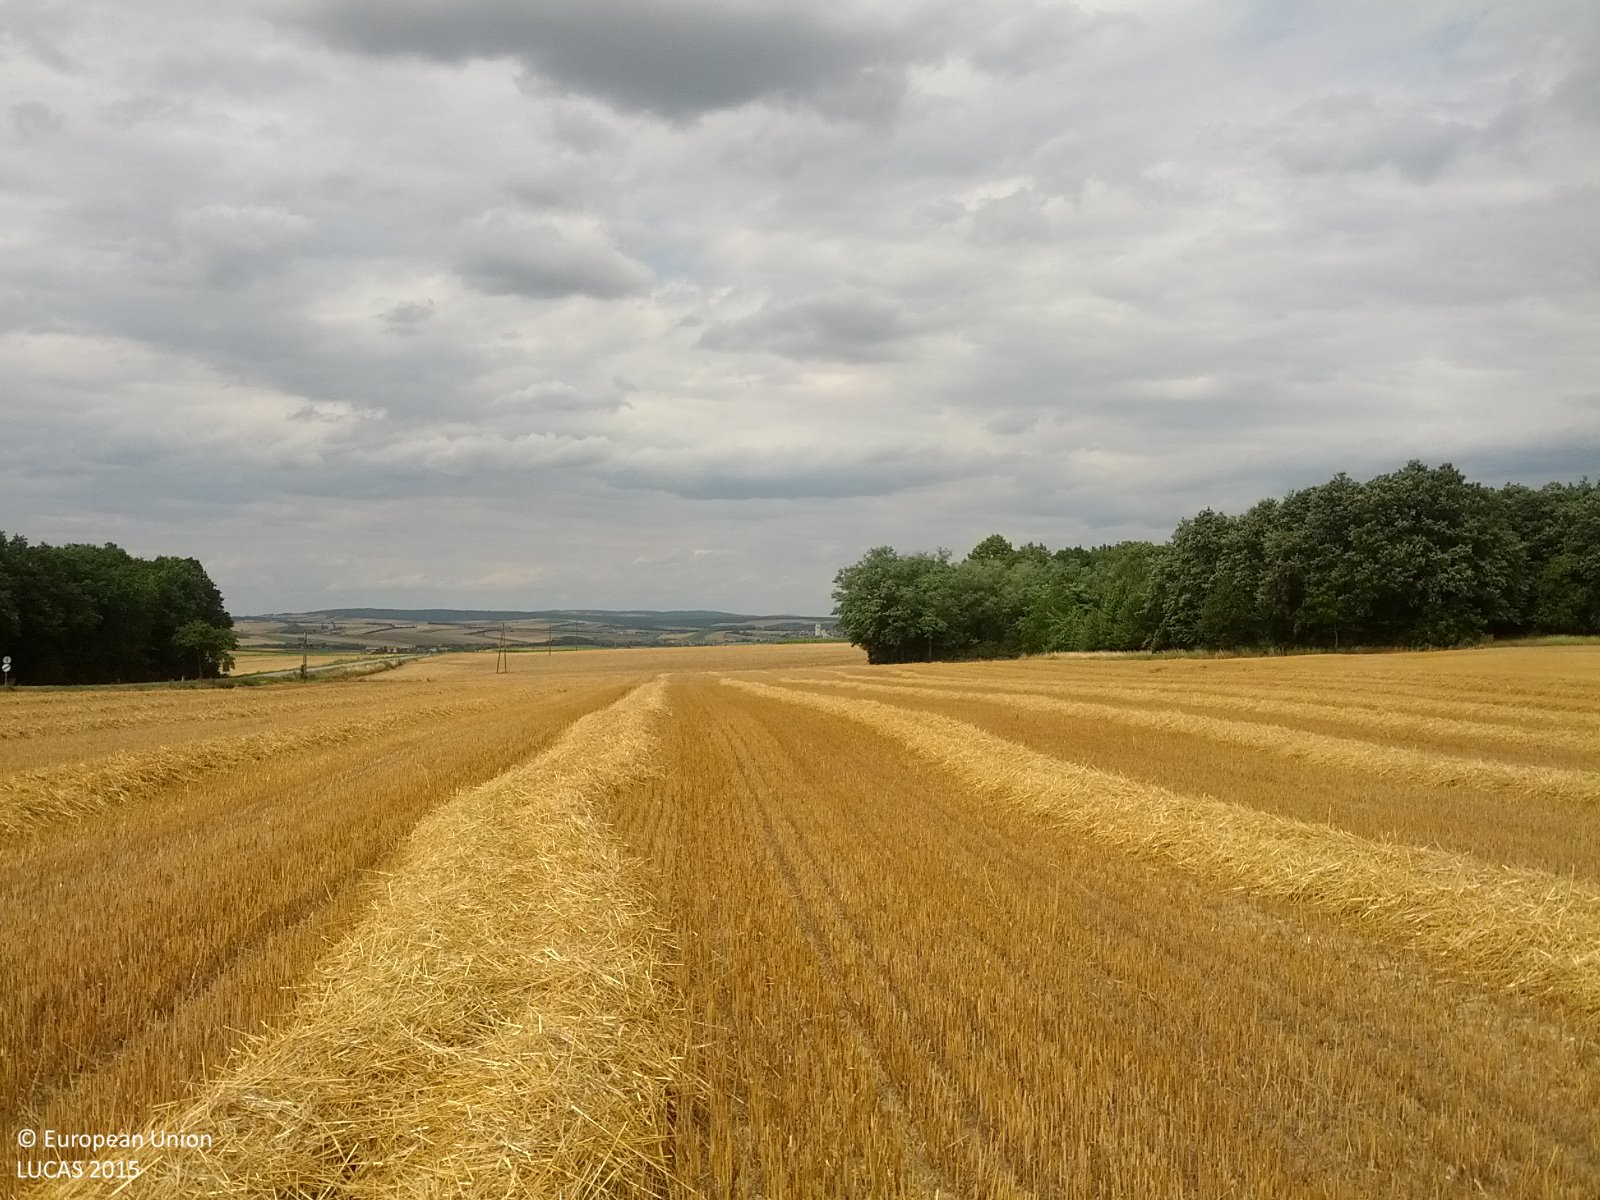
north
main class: Cropland
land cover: Common wheat
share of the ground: > 75 %
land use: Agriculture (excluding fallow land and kitchen gardens)
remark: Harvested field
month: July
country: AT
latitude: 48.5164
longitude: 16.5451
